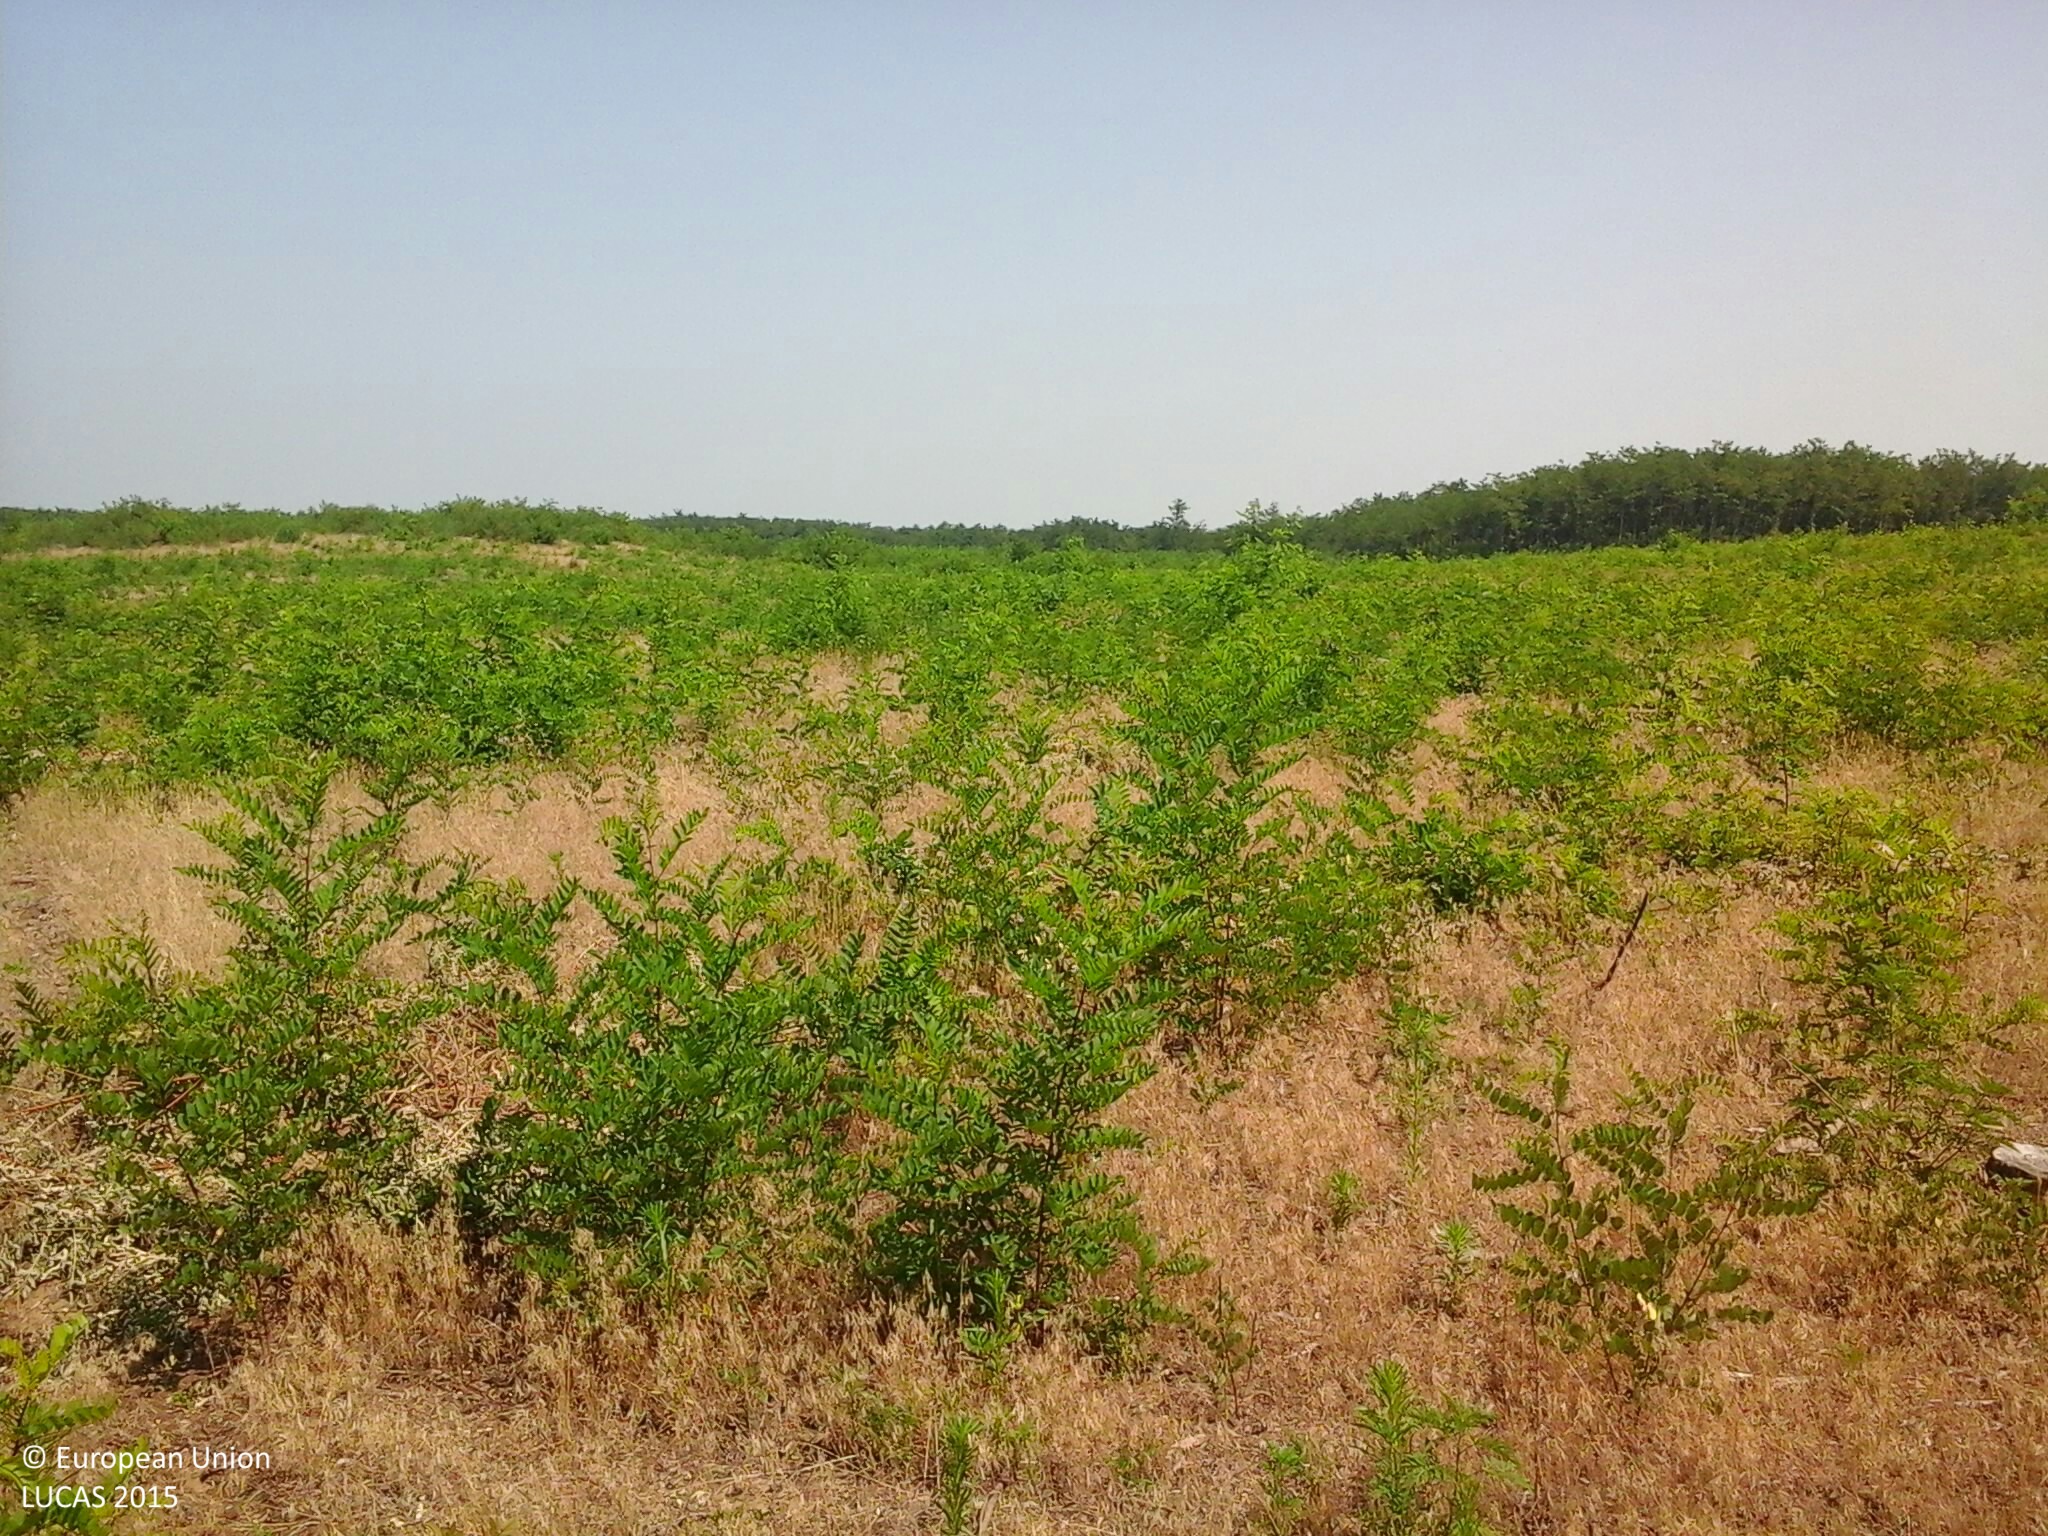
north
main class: Woodland
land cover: Broadleaved woodland
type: exotic forest
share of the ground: 10 - 25 %
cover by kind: herbaceous plants 85 %, broadleaved forest trees 15 %
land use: Semi-natural and natural areas not in use
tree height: < 5 m
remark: Nursery
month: July
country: HU
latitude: 47.8136
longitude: 22.0578
